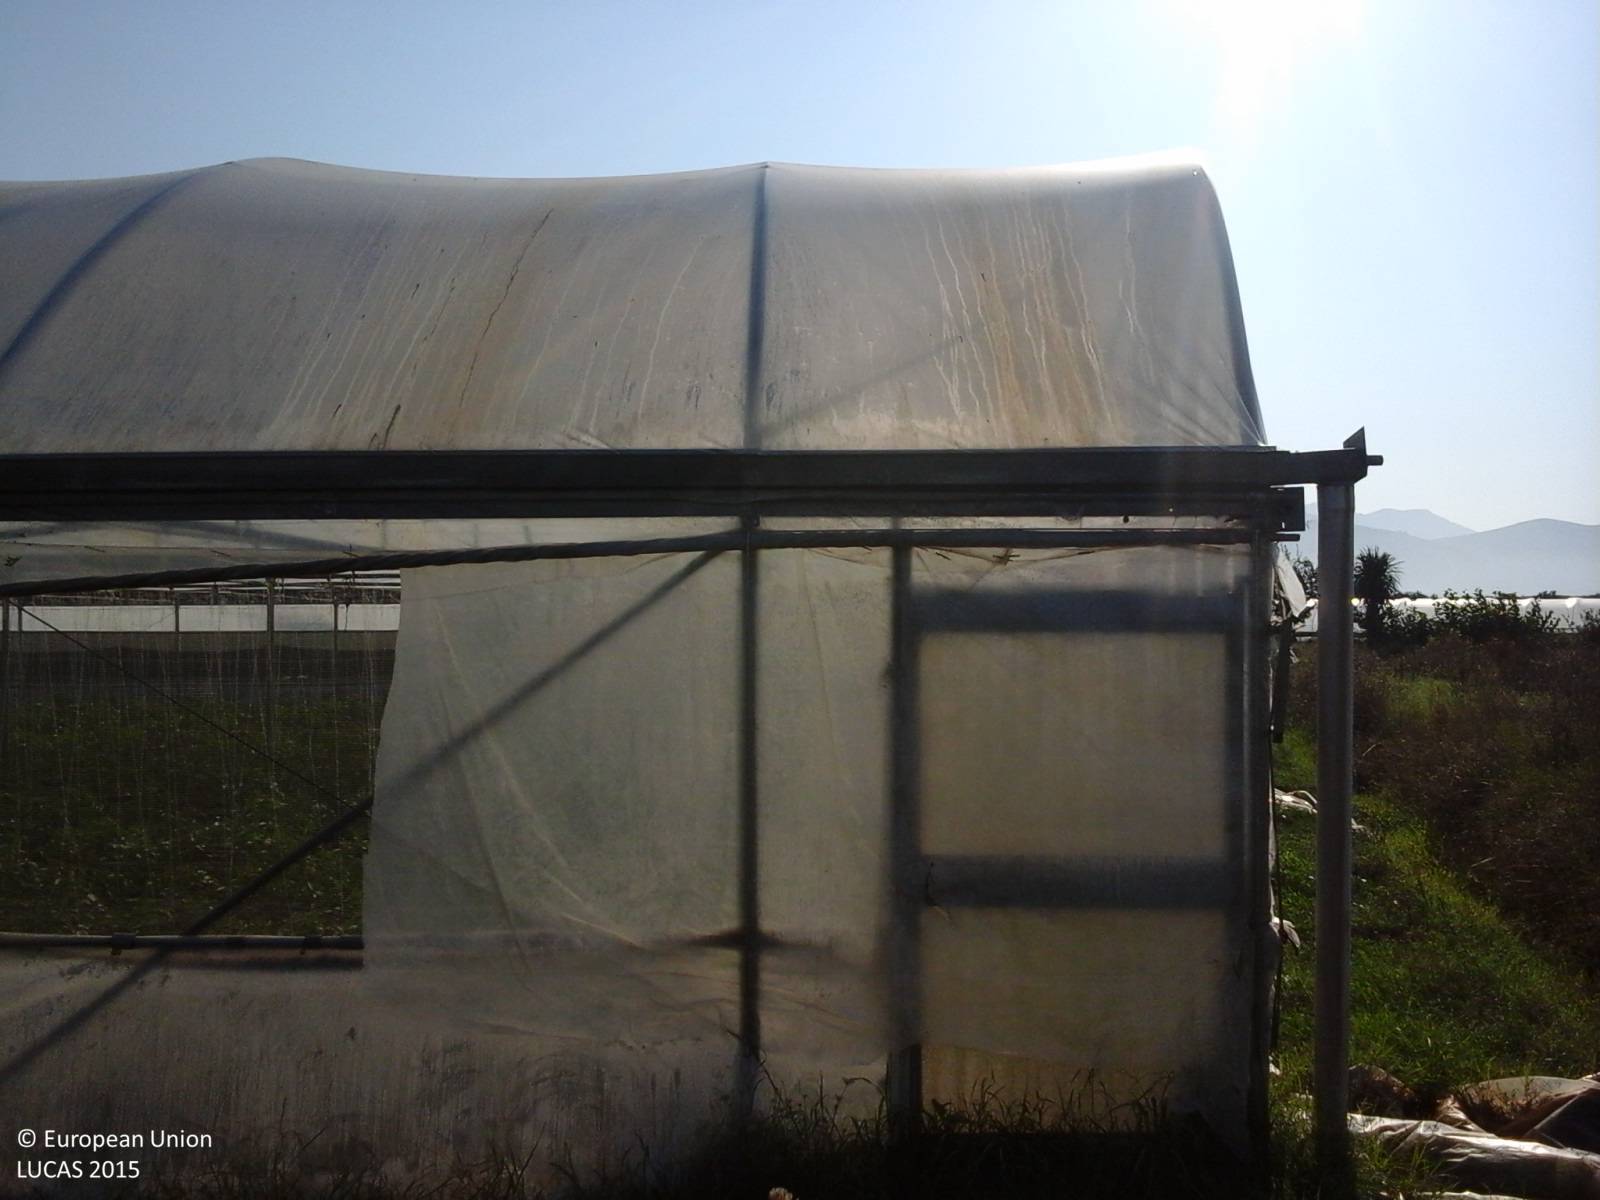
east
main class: Cropland
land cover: Olive groves
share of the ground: > 75 %
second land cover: Spontaneously vegetated surfaces
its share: > 75 %
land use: Agriculture (excluding fallow land and kitchen gardens)
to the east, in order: Olive groves; Spontaneously vegetated surfaces; Ditches and canals; Grass margins; Artificial constructions in urban areas; Grass margins; Ditches and canals; Other bare soil; Ditches and canals; Grass margins; Artificial constructions in urban areas; Grassland without tree/shrub cover; Artificial constructions in urban areas; Ditches and canals; Grassland without tree/shrub cover; Ditches and canals; Grassland without tree/shrub cover
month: August
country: IT
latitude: 41.3321
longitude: 13.3680
